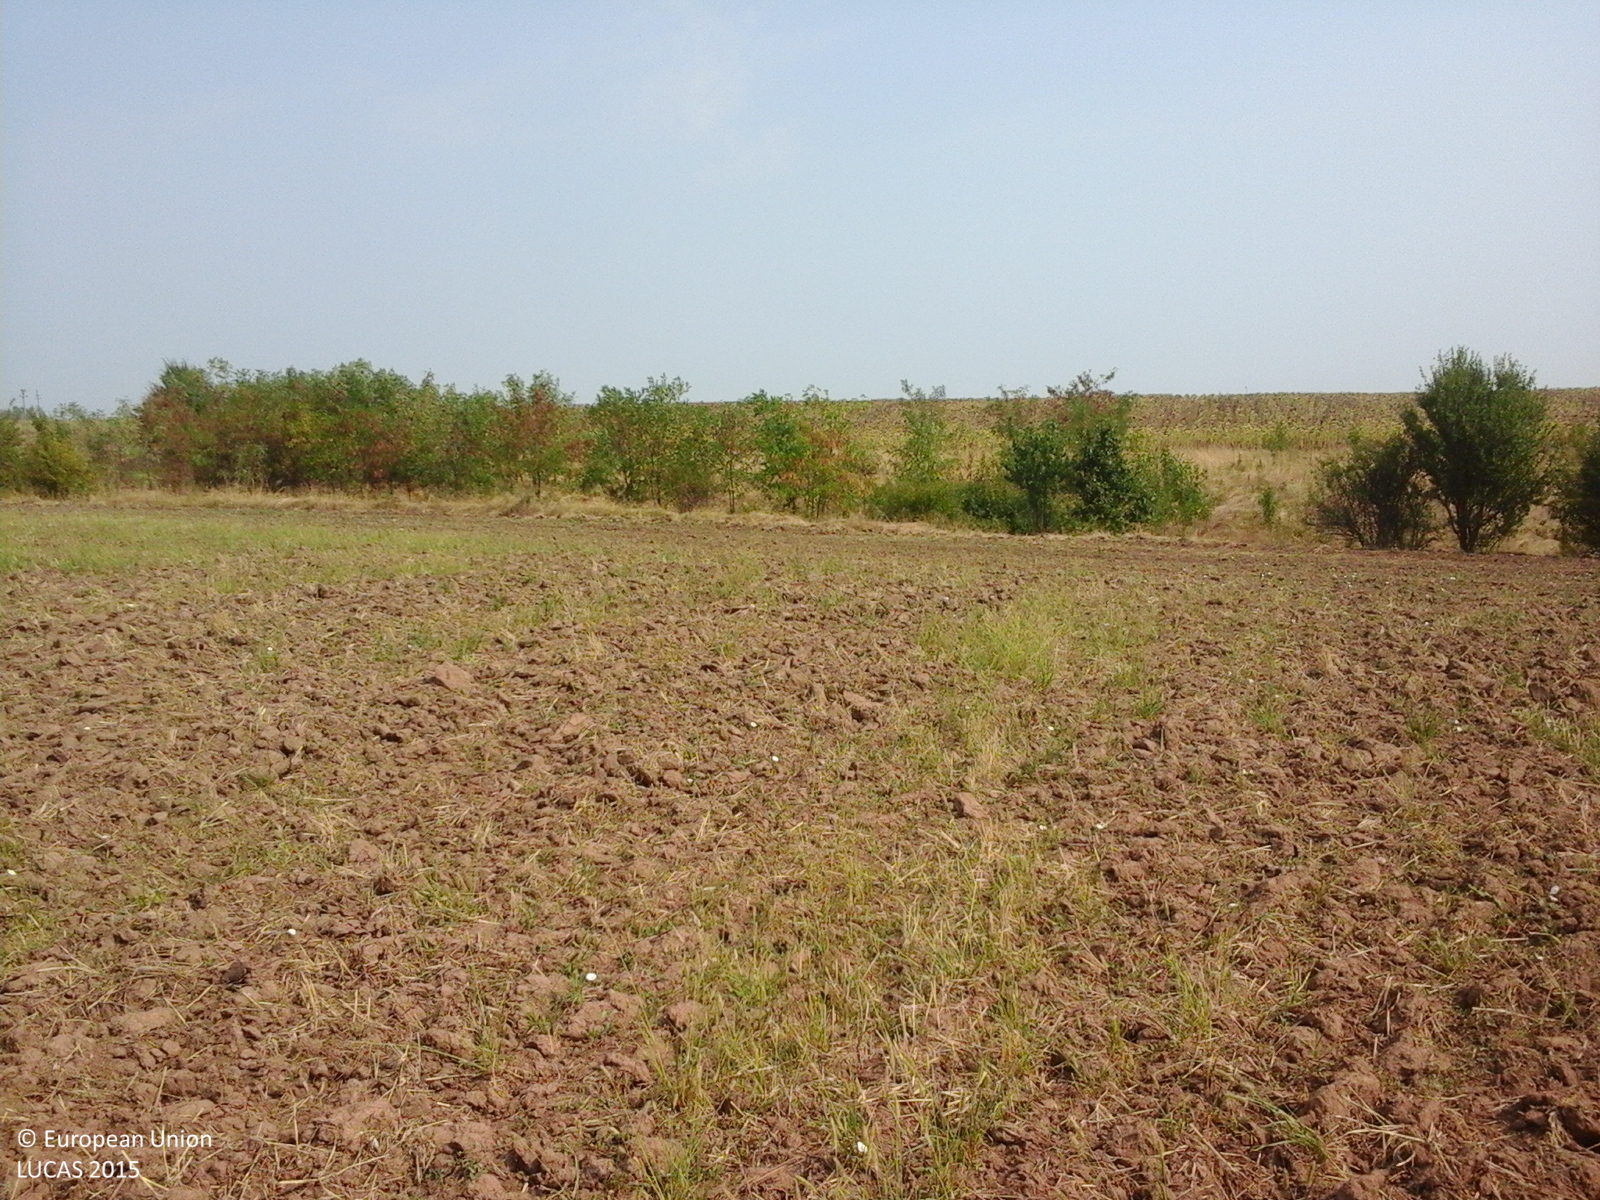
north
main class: Cropland
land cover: Durum wheat
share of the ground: 25 - 50 %
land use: Agriculture (excluding fallow land and kitchen gardens)
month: August
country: RO
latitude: 44.2683
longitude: 23.4933
